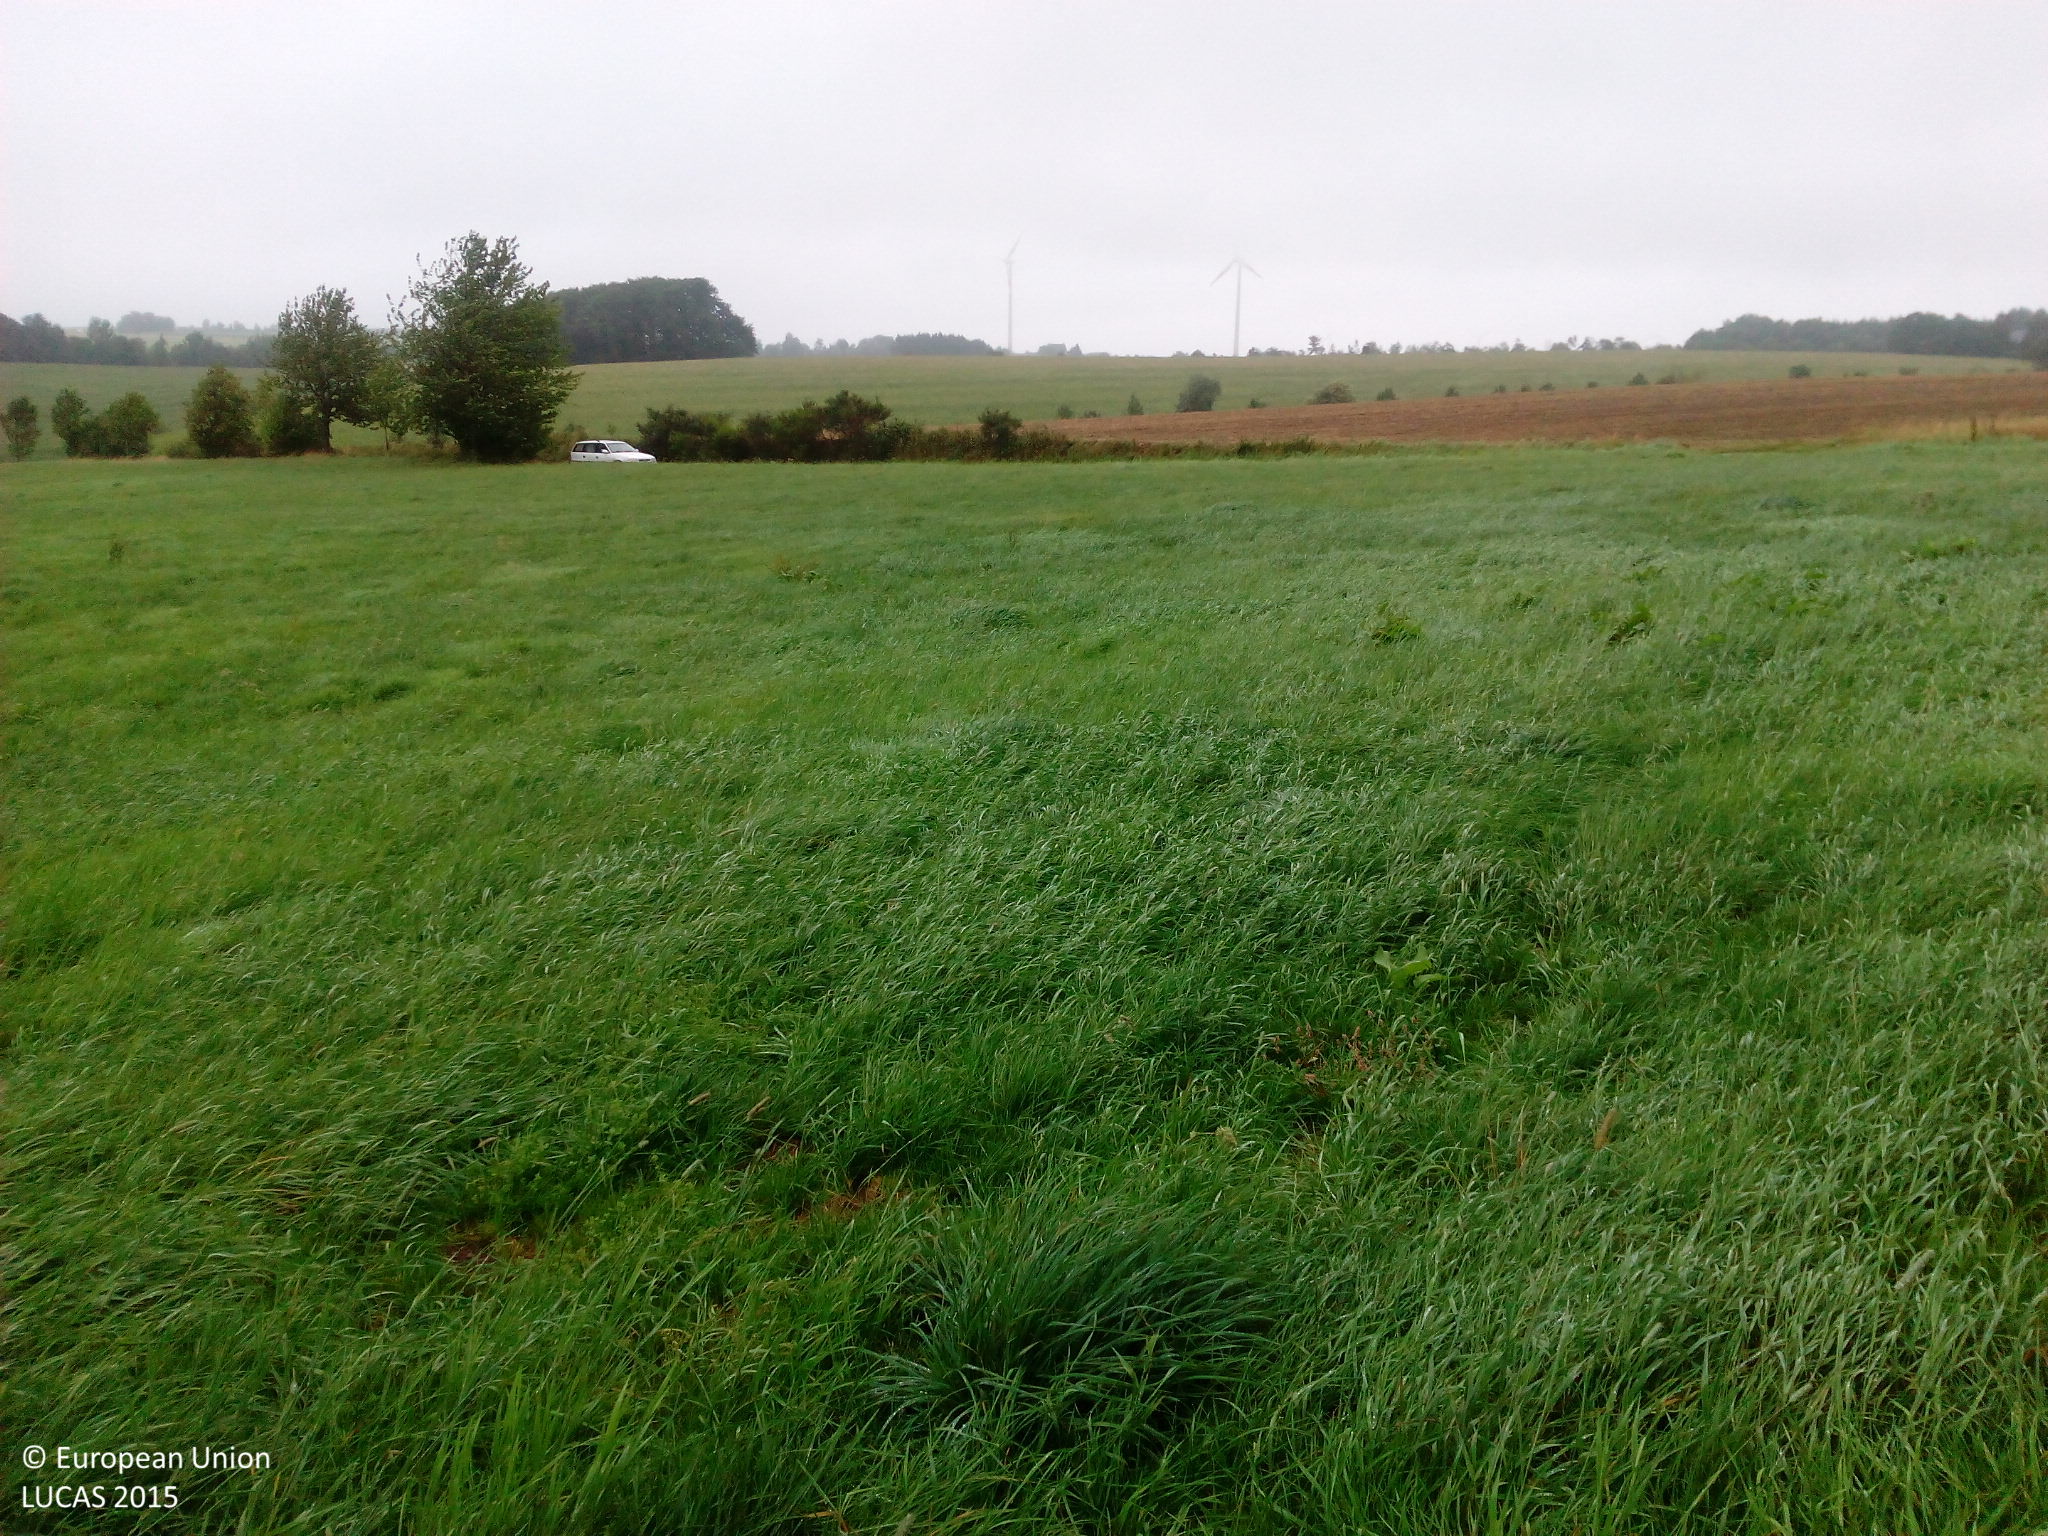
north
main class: Grassland
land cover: Grassland without tree/shrub cover
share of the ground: > 75 %
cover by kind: herbaceous plants 100 %
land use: Agriculture (excluding fallow land and kitchen gardens)
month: August
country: DE
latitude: 50.0881
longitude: 6.2956
